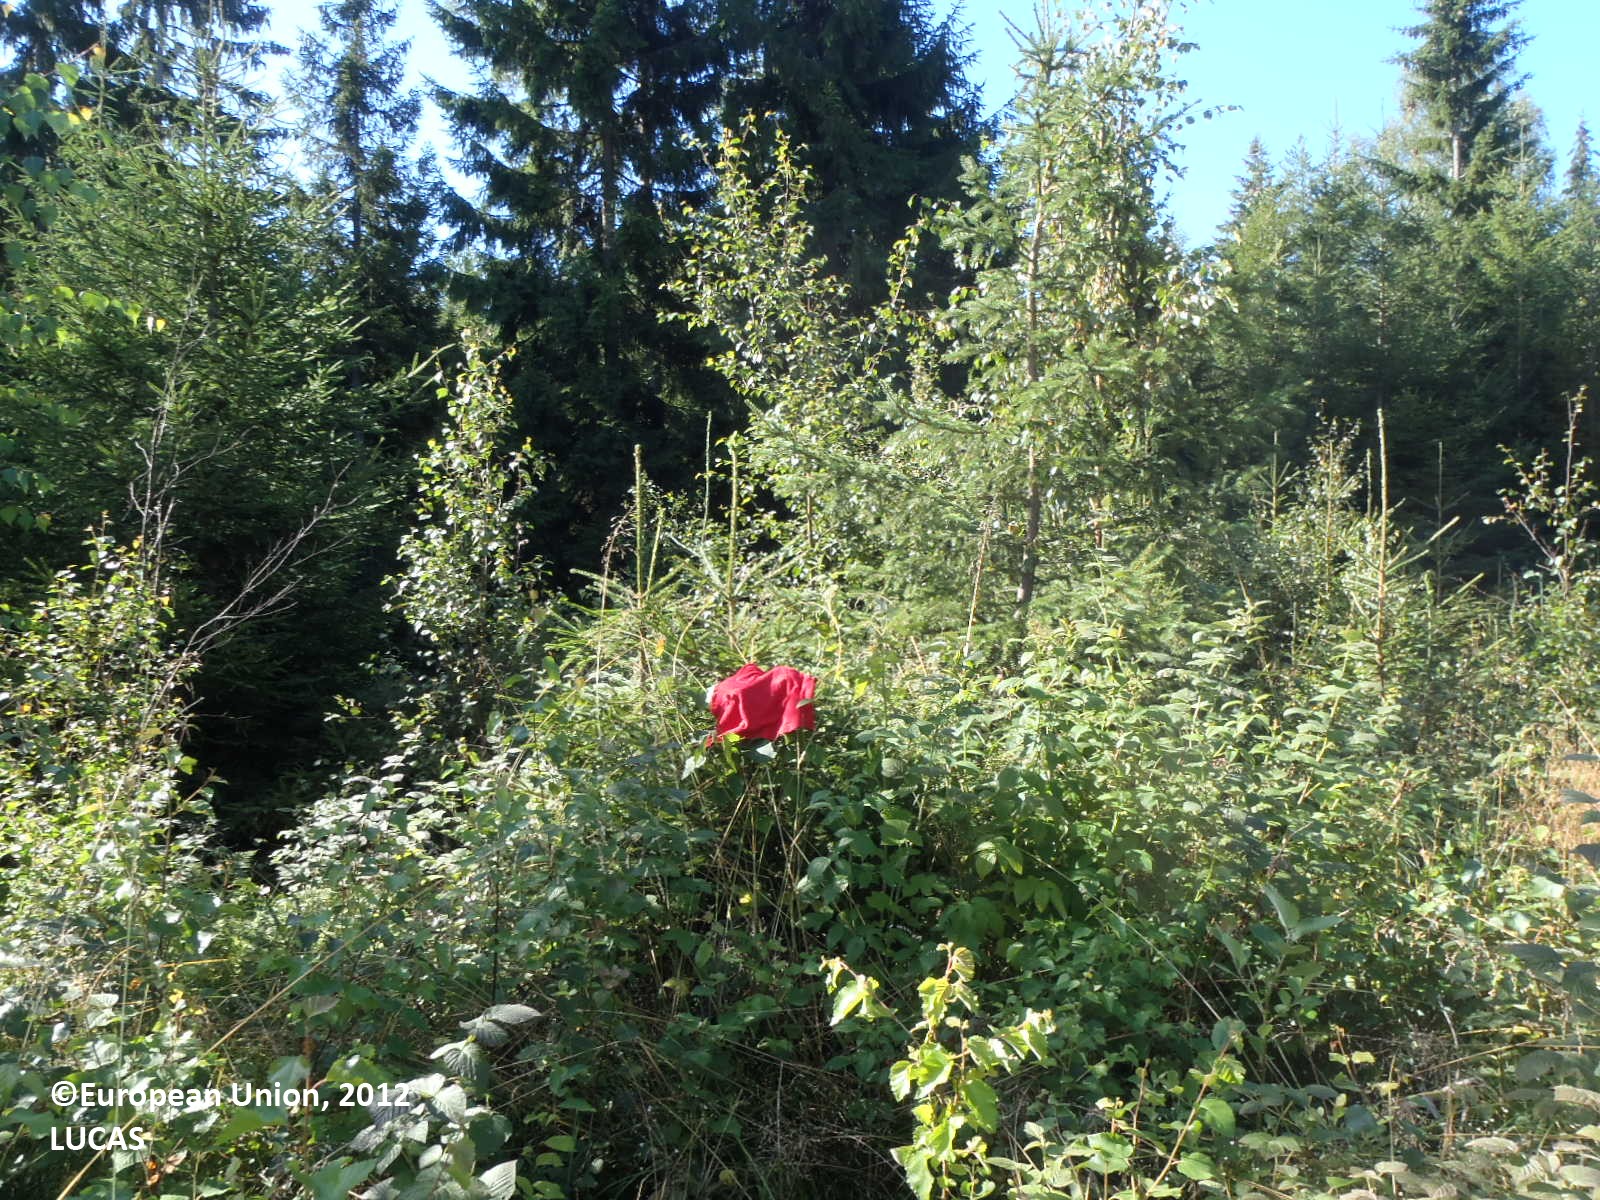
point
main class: Woodland
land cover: Spruce dominated mixed woodland
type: boreal forest
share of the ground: > 75 %
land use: Forestry
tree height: > 5 m
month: August
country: FI
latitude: 60.2455
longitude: 22.2616
